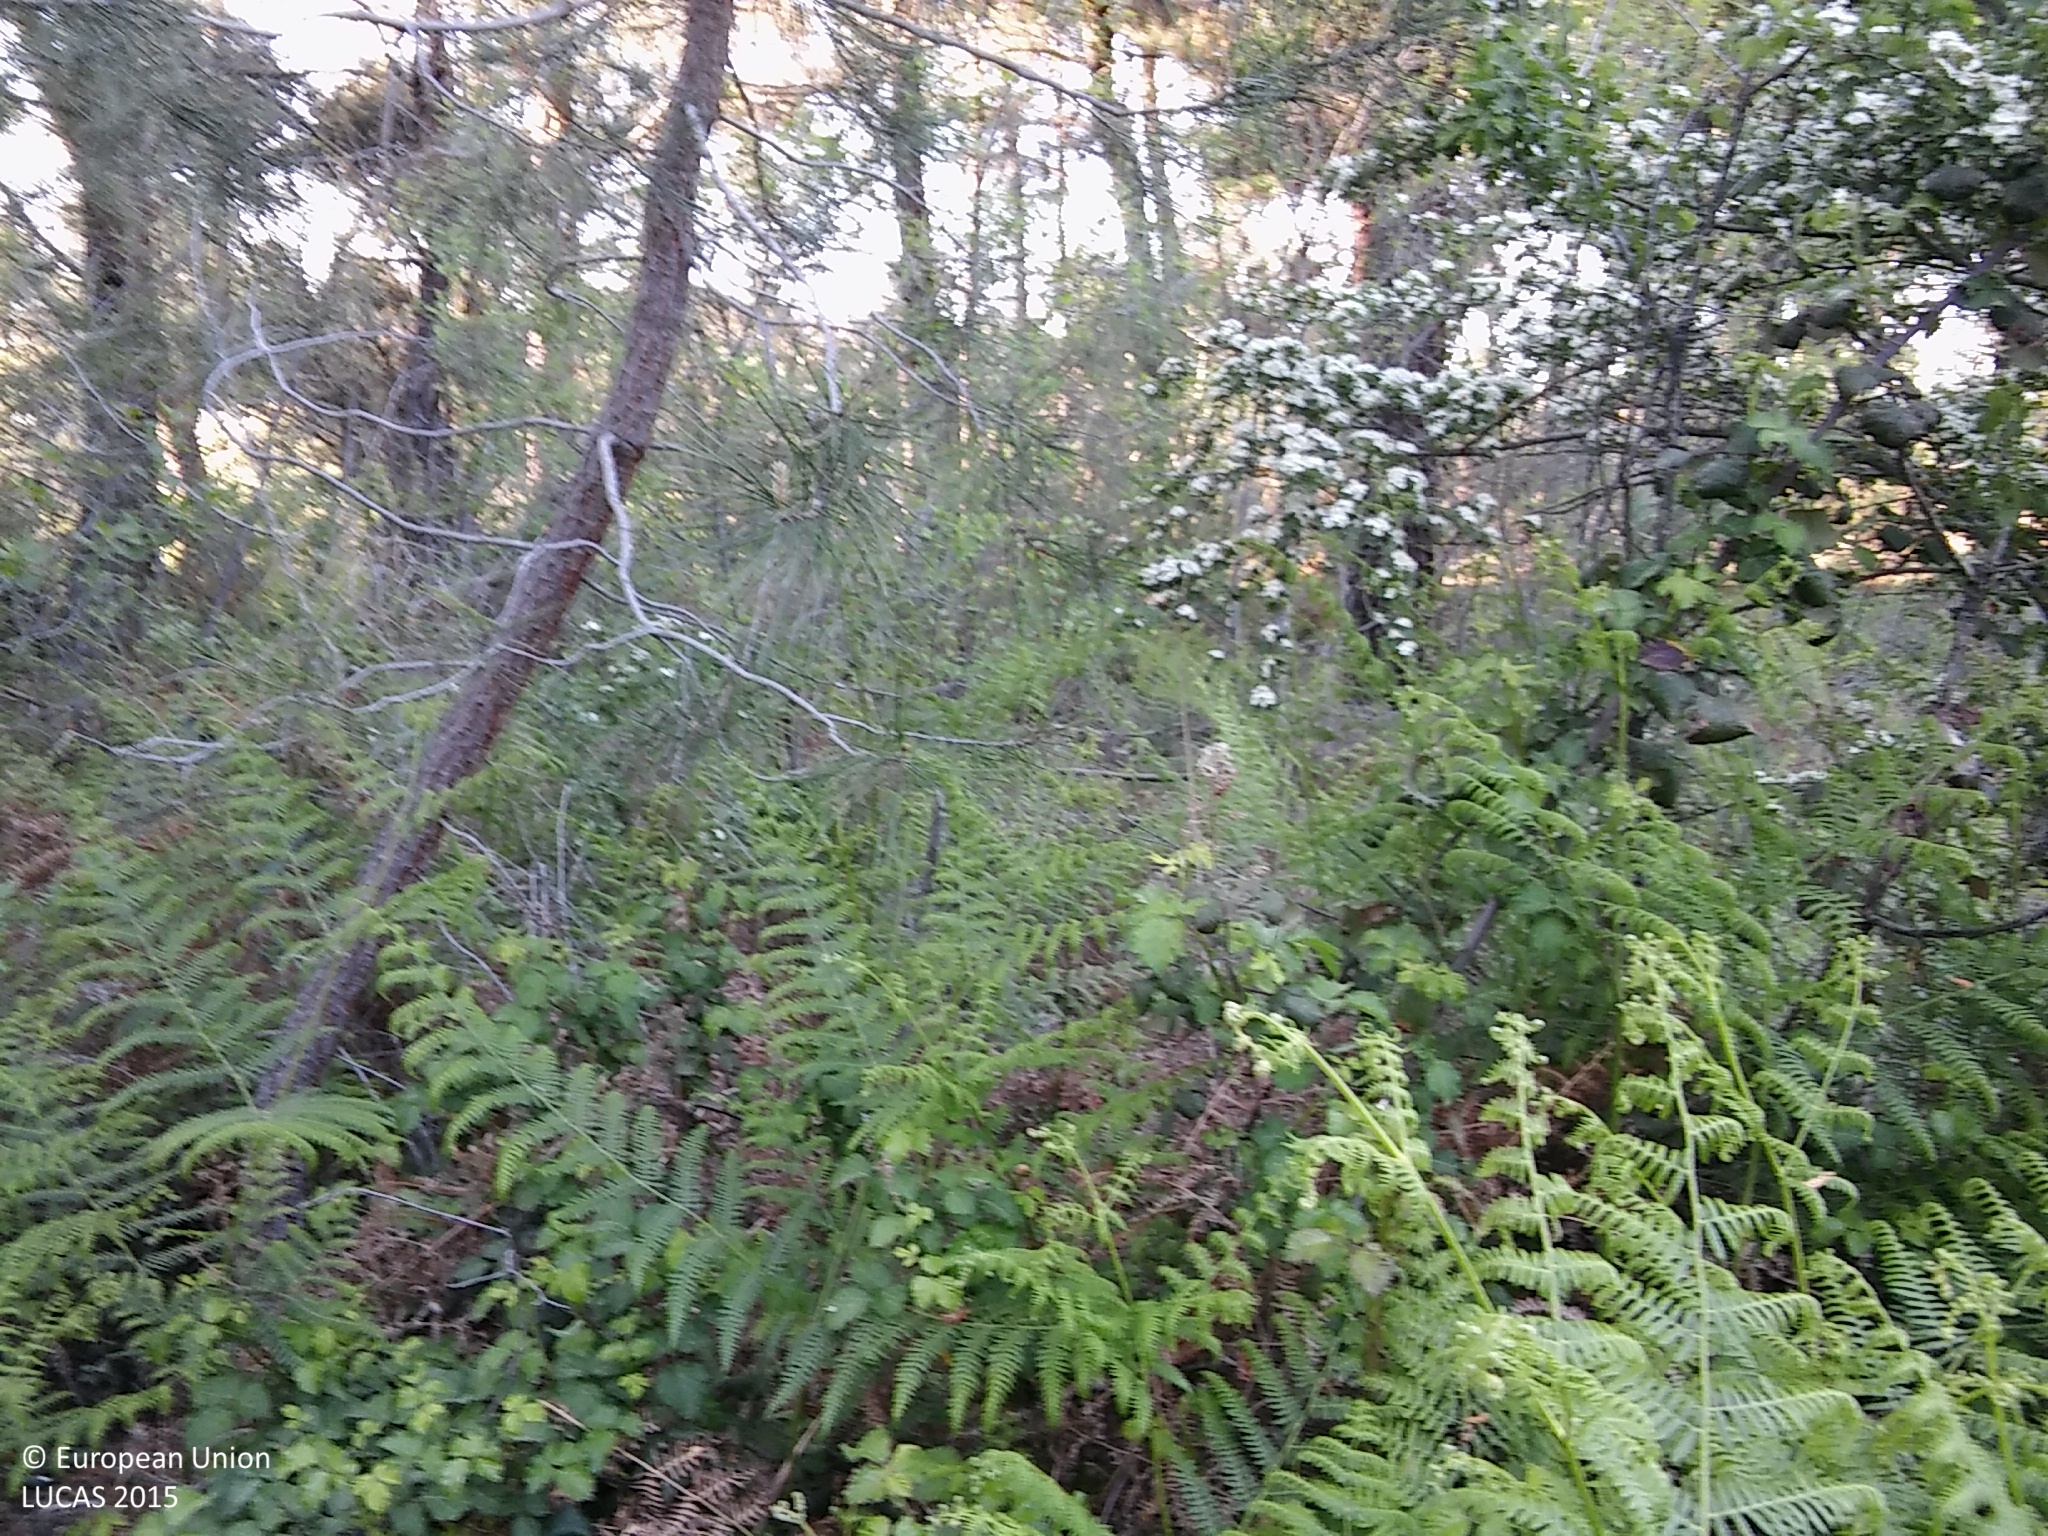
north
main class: Woodland
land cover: Pine dominated mixed woodland
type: coniferous forest of the mediterranean region
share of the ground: 50 - 75 %
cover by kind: coniferous forest trees 55 %, broadleaved forest trees 20 %, shrubs 20 %, herbaceous plants 5 %
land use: Forestry
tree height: > 5 m
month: May
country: ES
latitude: 41.3466
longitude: -4.0007
